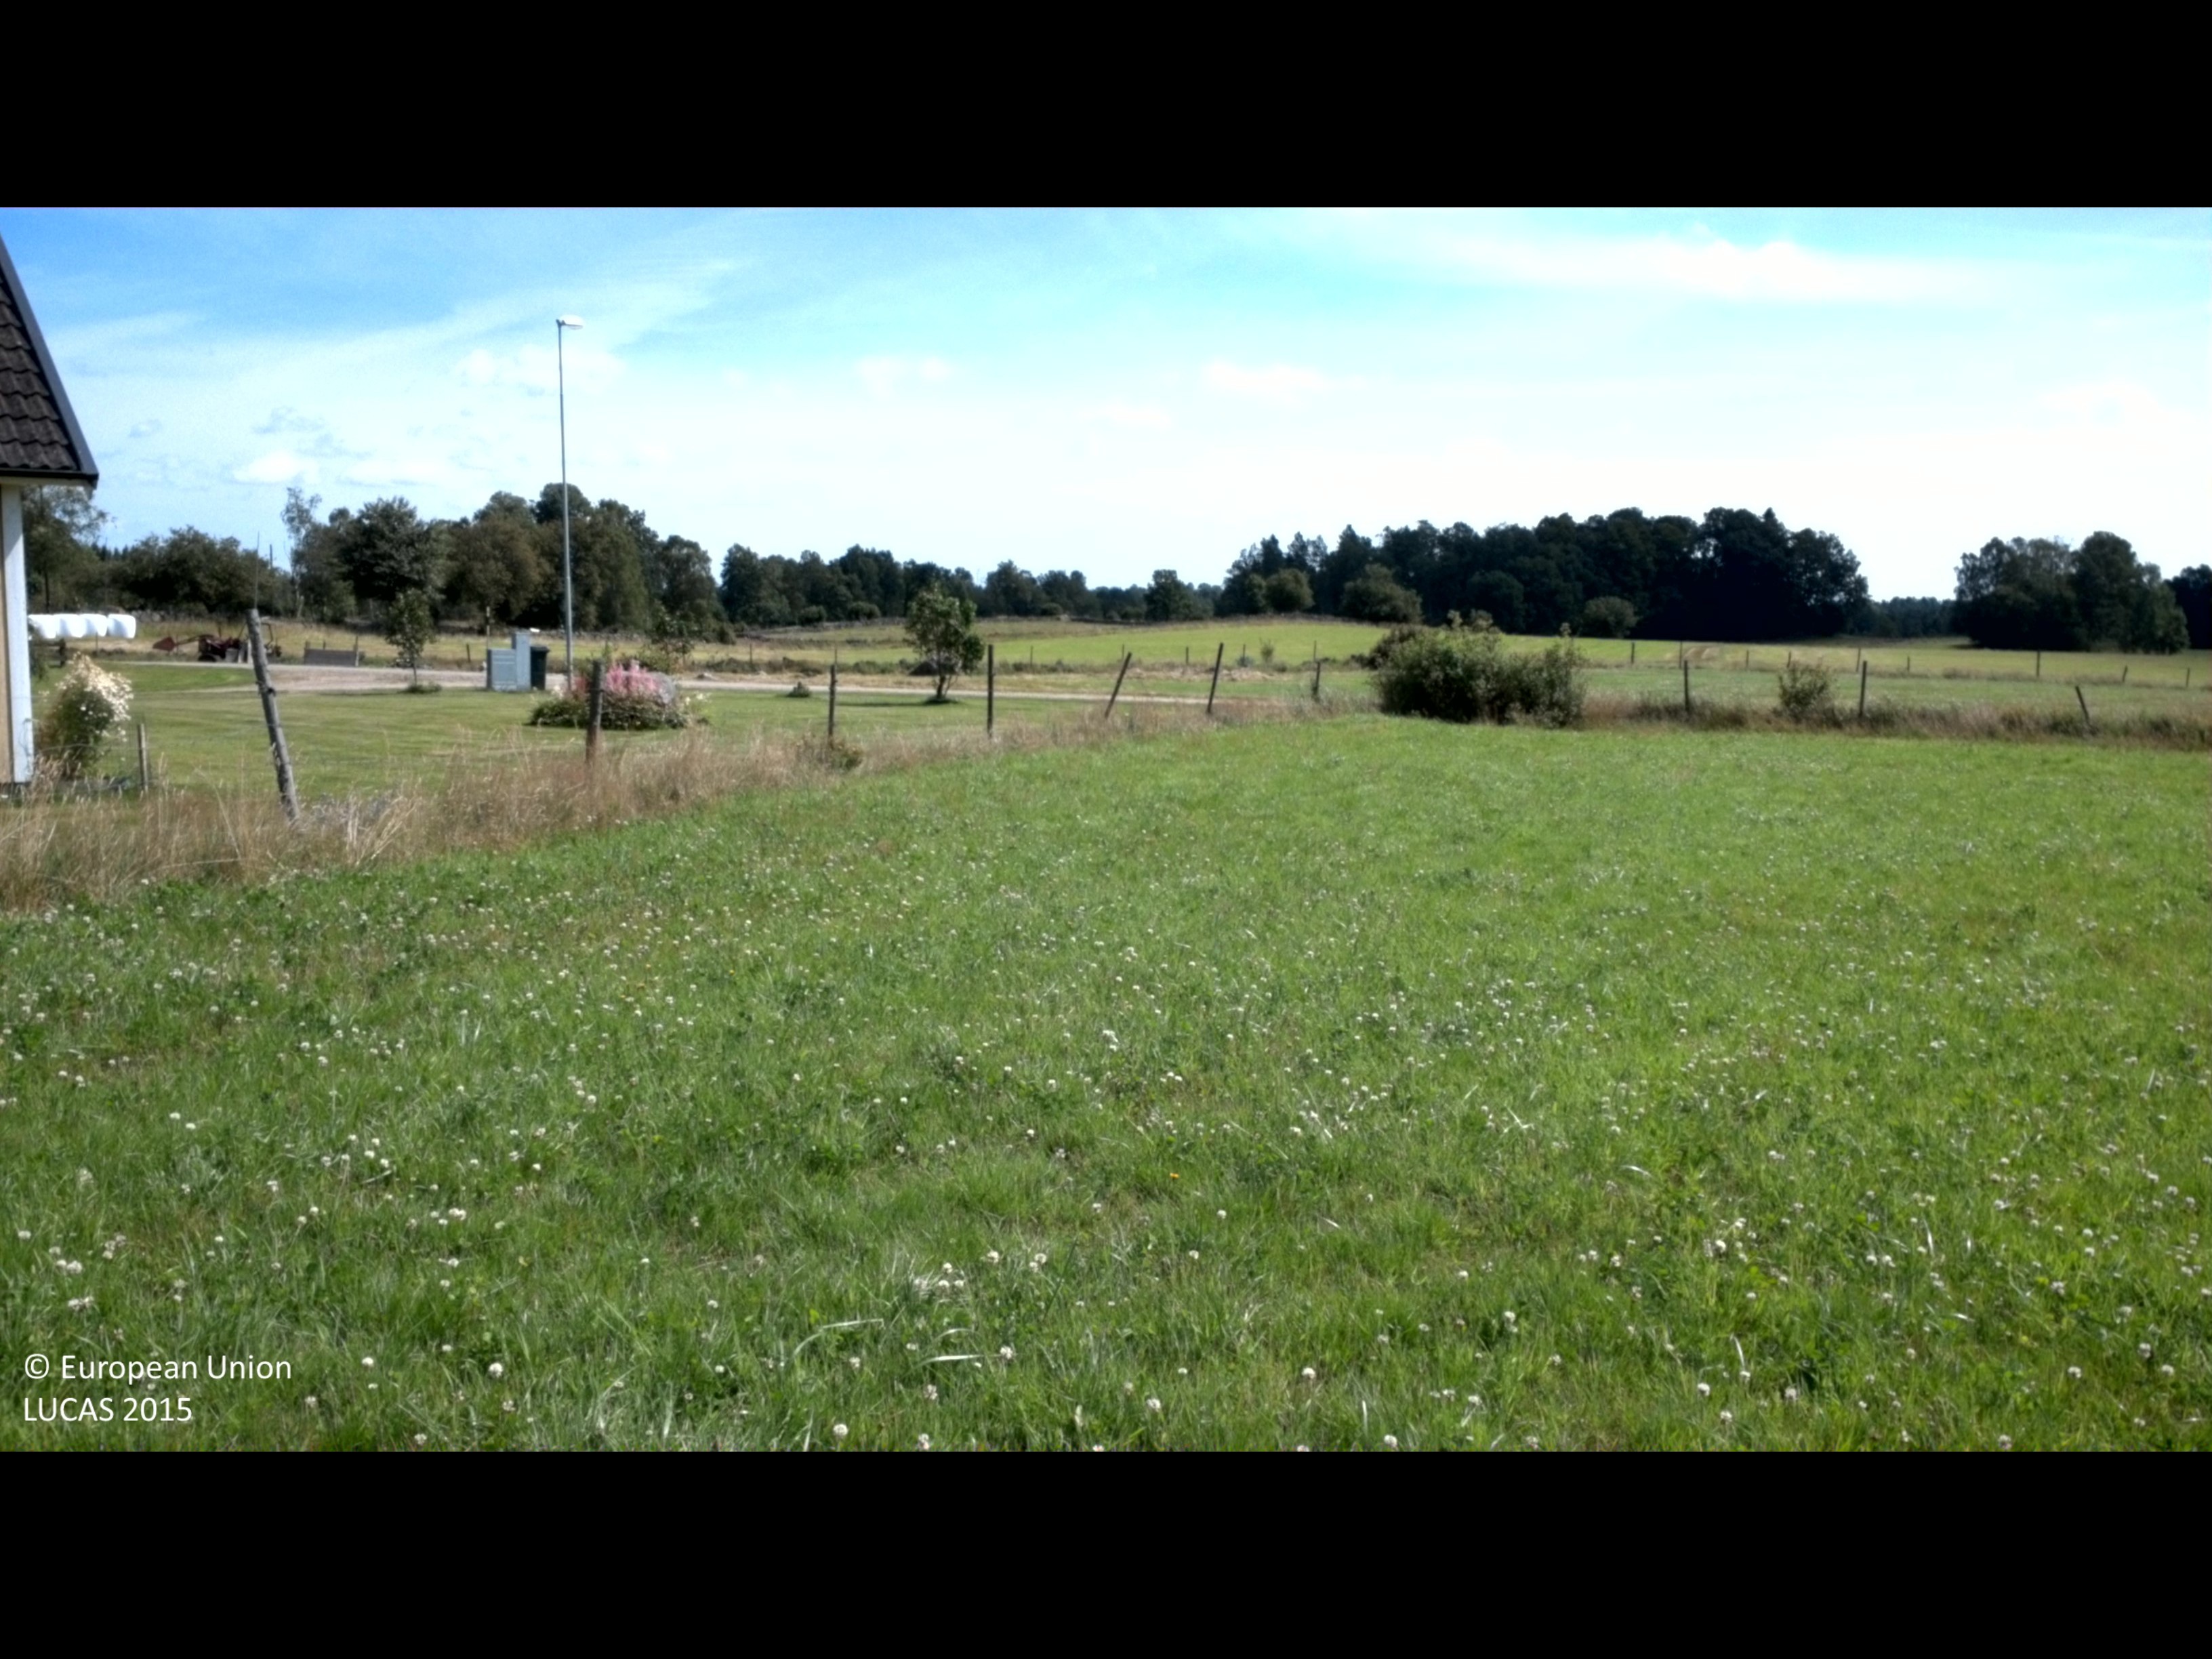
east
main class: Grassland
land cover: Grassland without tree/shrub cover
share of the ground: > 75 %
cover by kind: herbaceous plants 100 %
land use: Agriculture (excluding fallow land and kitchen gardens)
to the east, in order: Grassland without tree/shrub cover; Fences; Artificial constructions in urban areas; Grassland without tree/shrub cover; Fences; Tracks; Grassland without tree/shrub cover; Dry stone walls; Fences; Grassland without tree/shrub cover
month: August
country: SE
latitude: 56.5809
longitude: 13.8227
